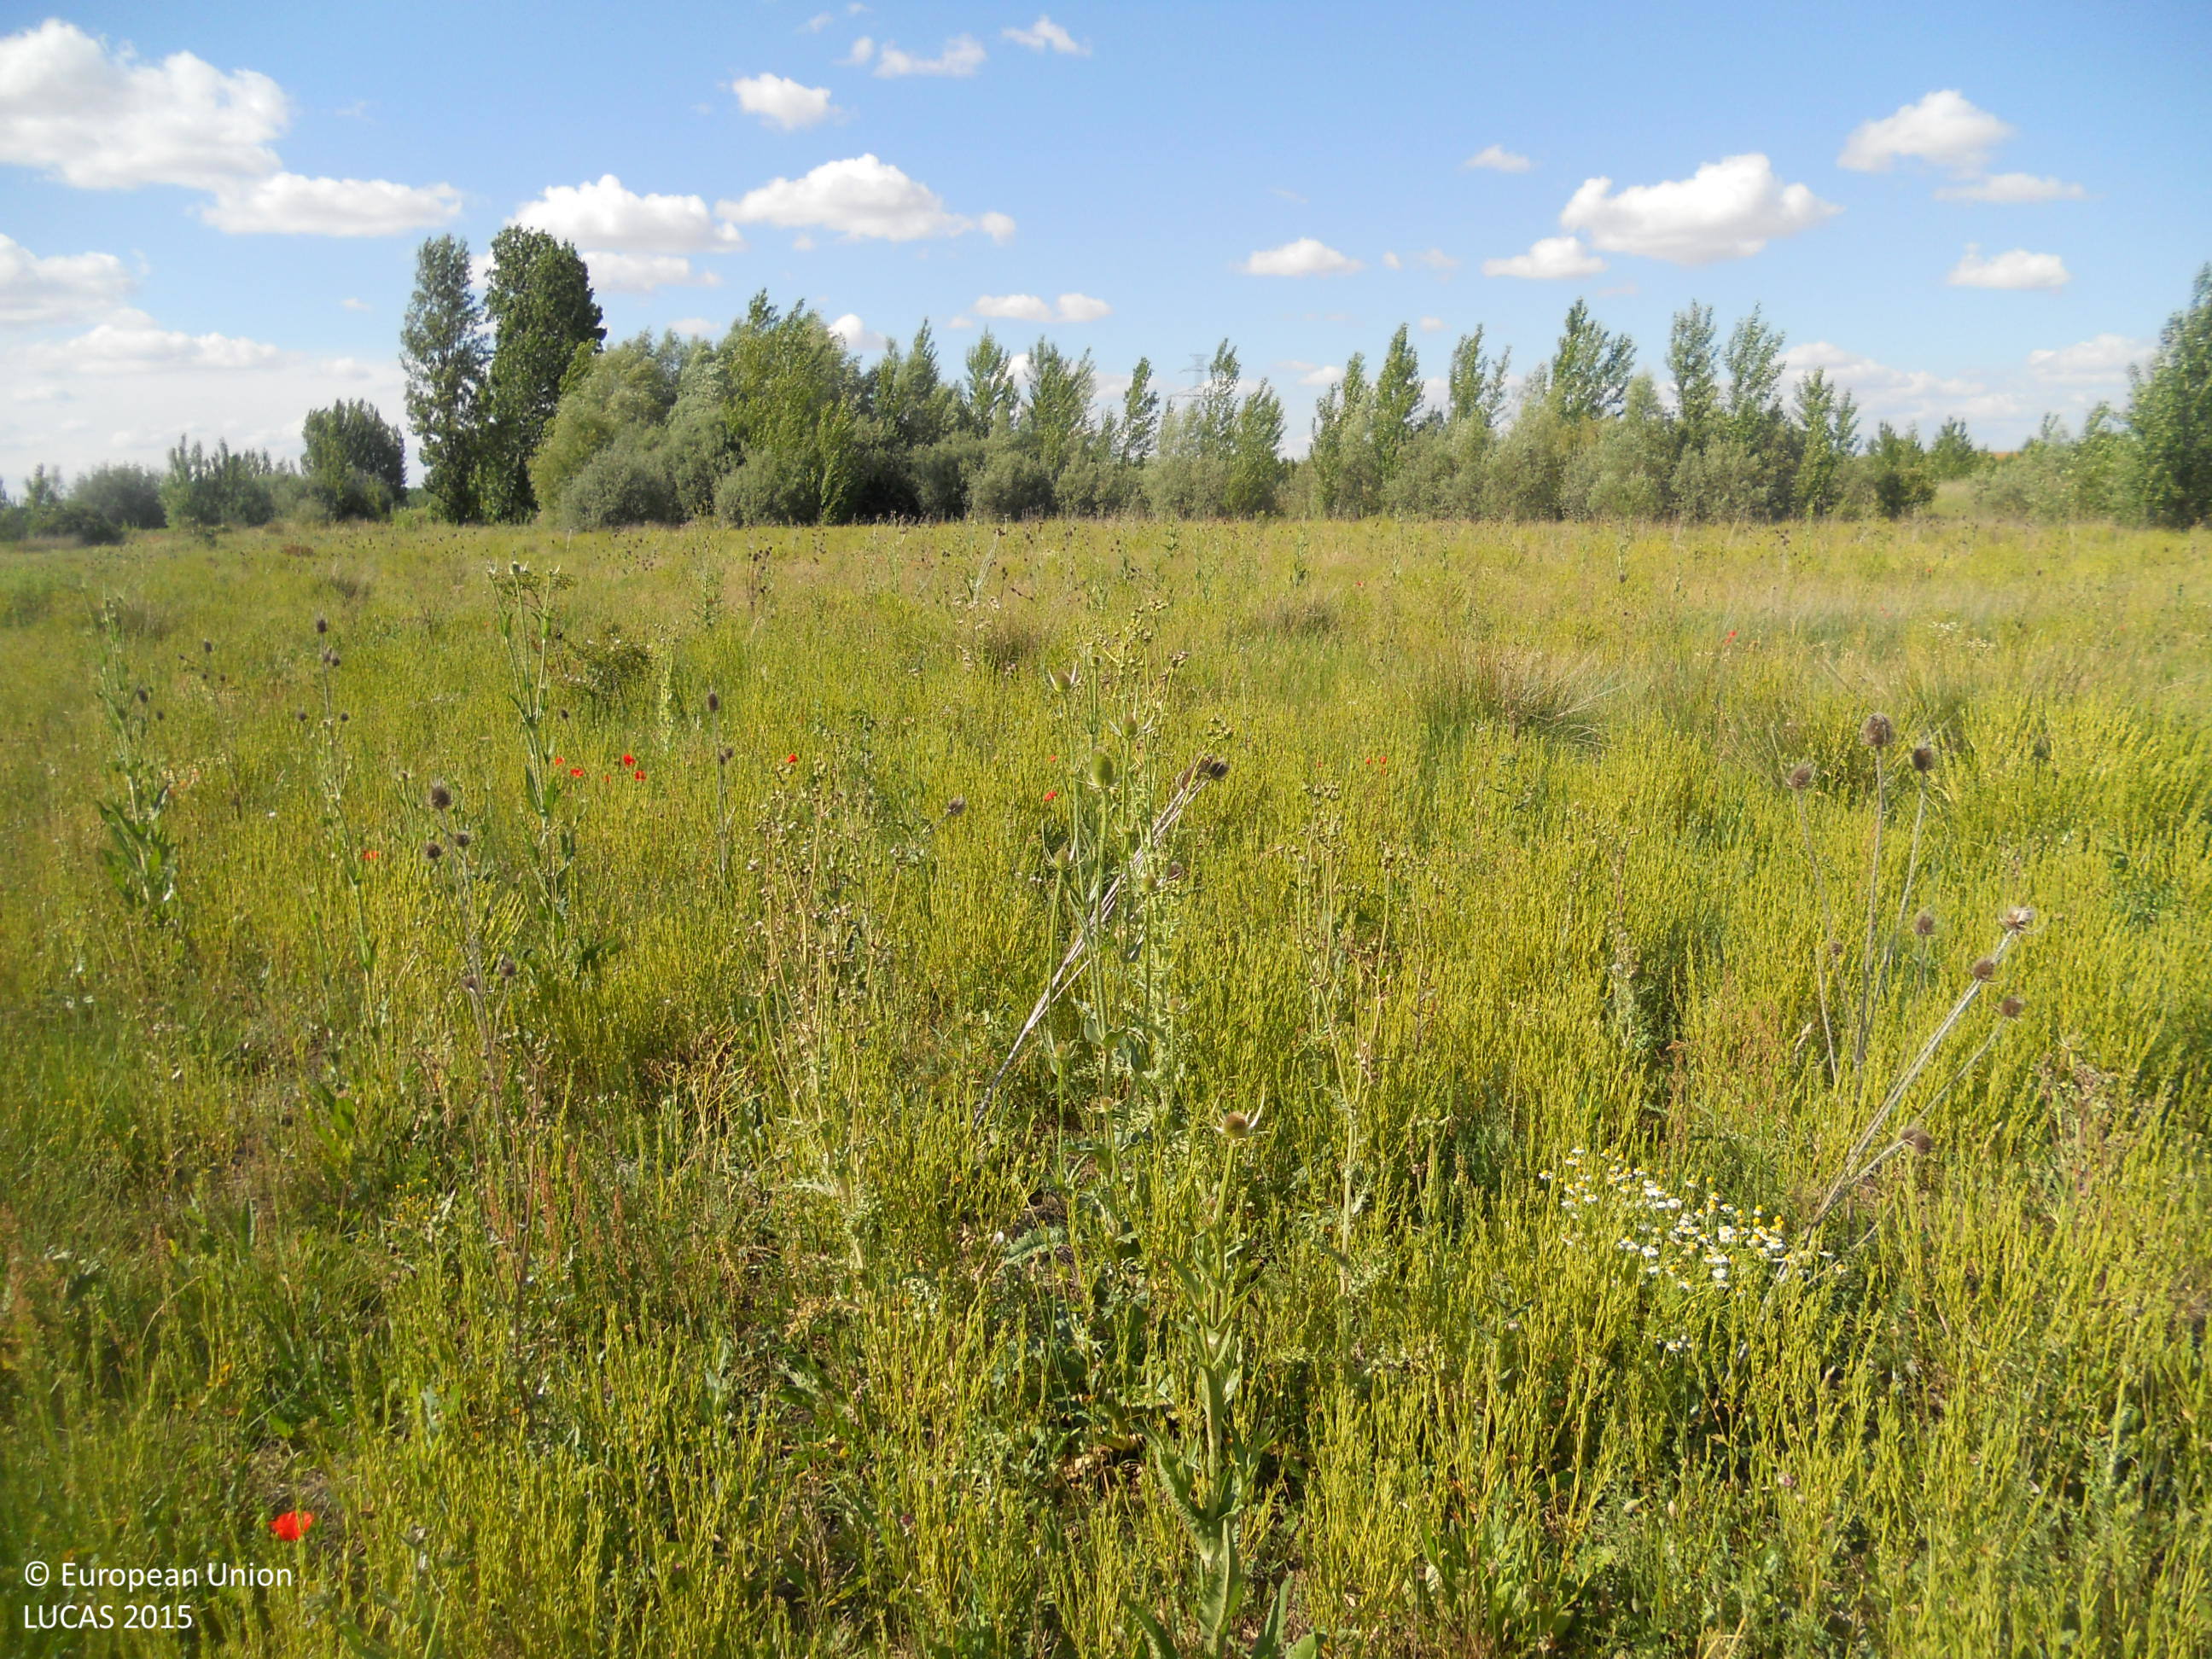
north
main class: Grassland
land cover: Grassland without tree/shrub cover
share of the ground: > 75 %
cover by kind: herbaceous plants 100 %
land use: Abandoned areas
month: June
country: ES
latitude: 42.2087
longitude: -5.2383
